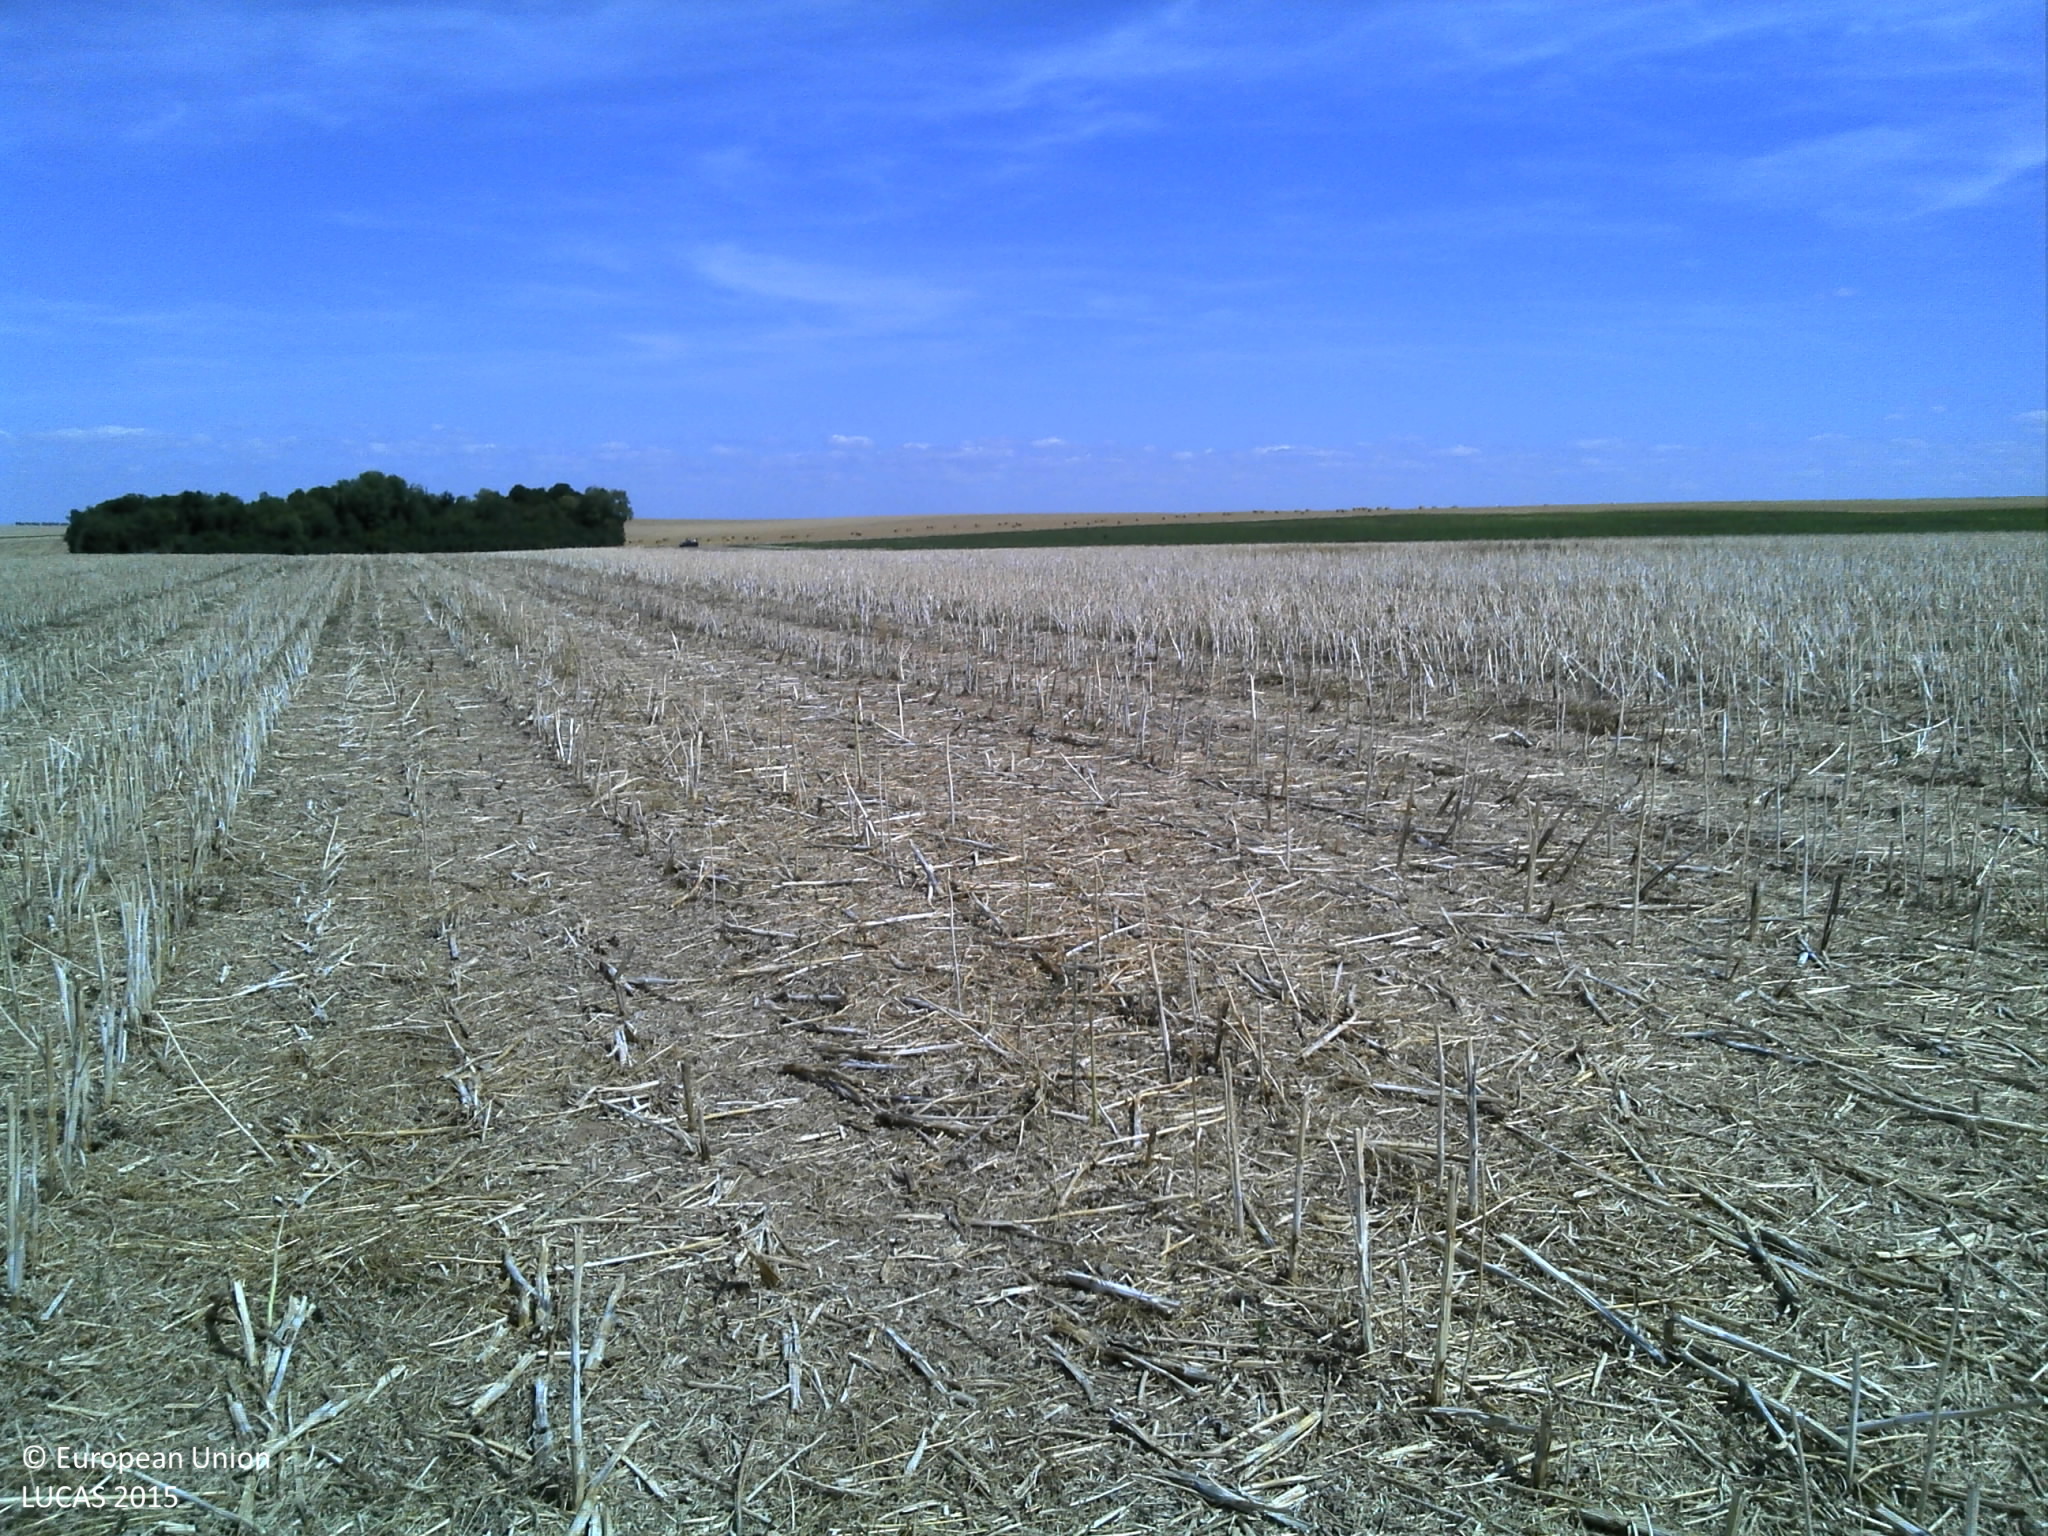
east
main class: Cropland
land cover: Rape and turnip rape
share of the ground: > 75 %
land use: Agriculture (excluding fallow land and kitchen gardens)
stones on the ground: < 10 %
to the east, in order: Rape and turnip rape
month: August
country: FR
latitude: 48.9967
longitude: 4.6803
